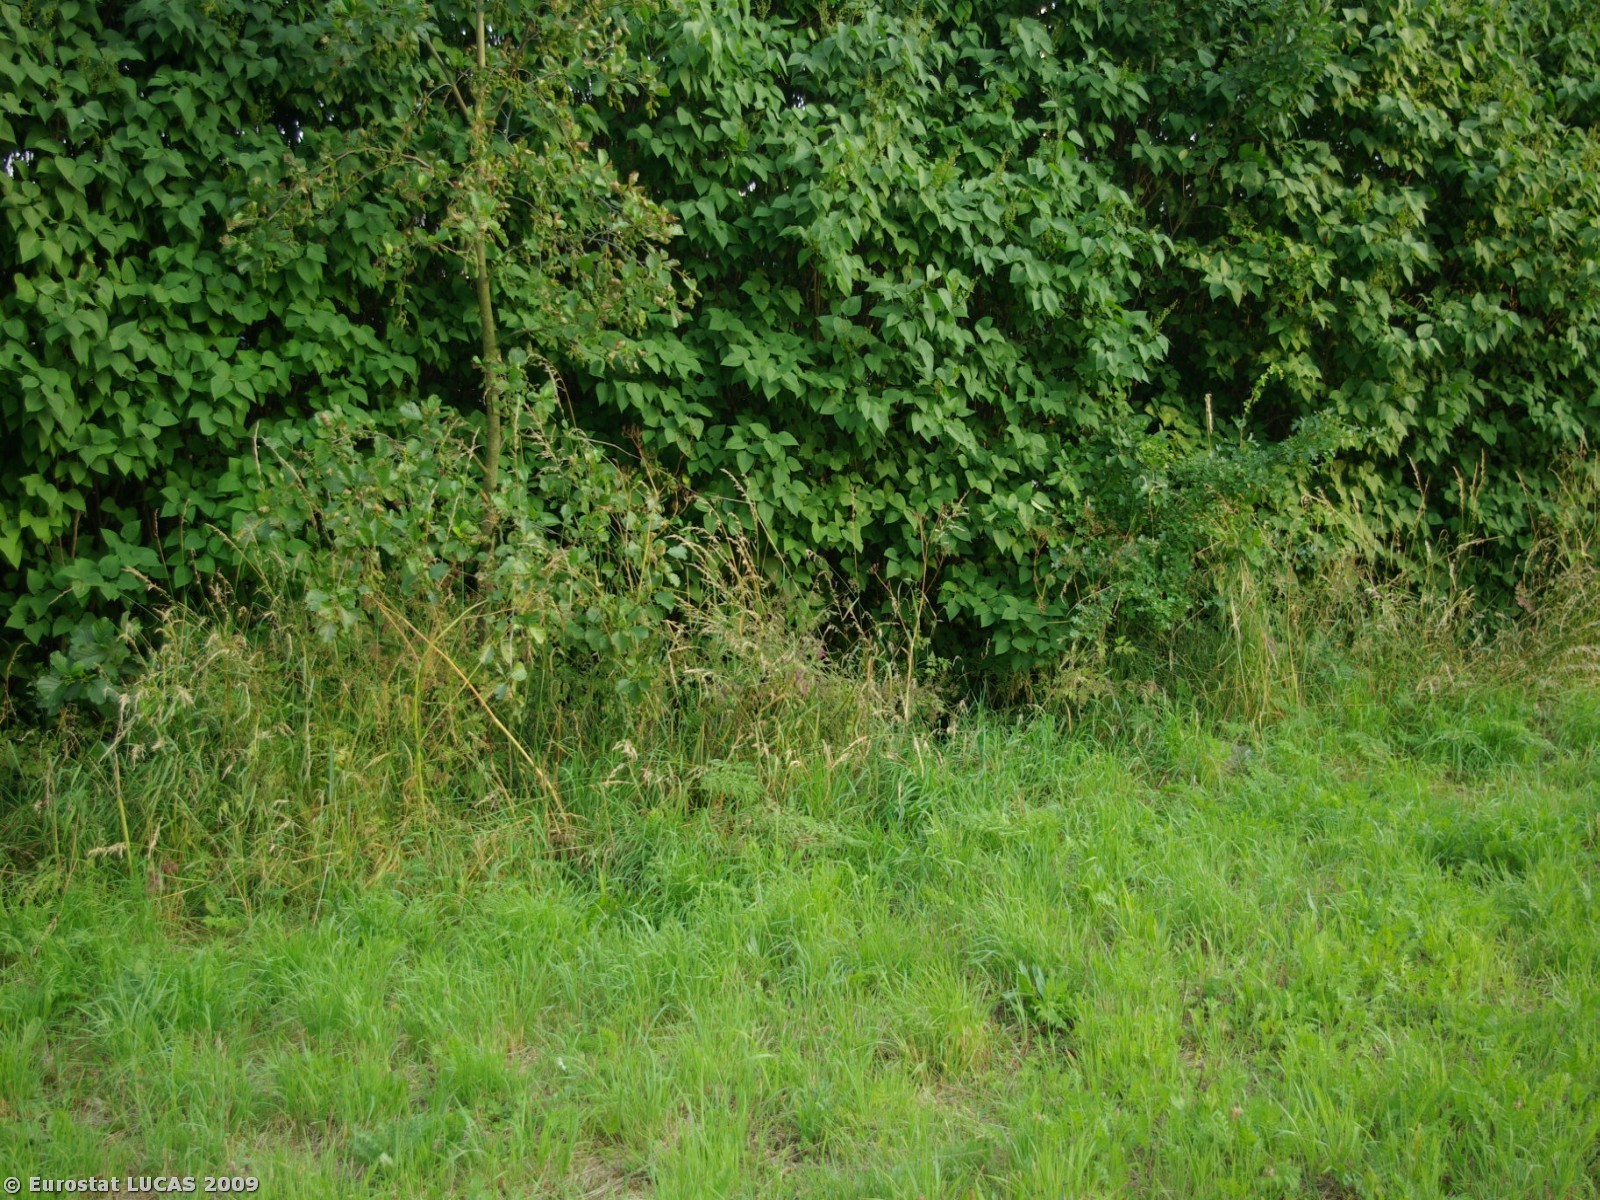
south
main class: Grassland
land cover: Grassland without tree/shrub cover
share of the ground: > 75 %
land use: Agriculture (excluding fallow land and kitchen gardens)
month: July
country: DK
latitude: 54.9294
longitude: 9.7973
